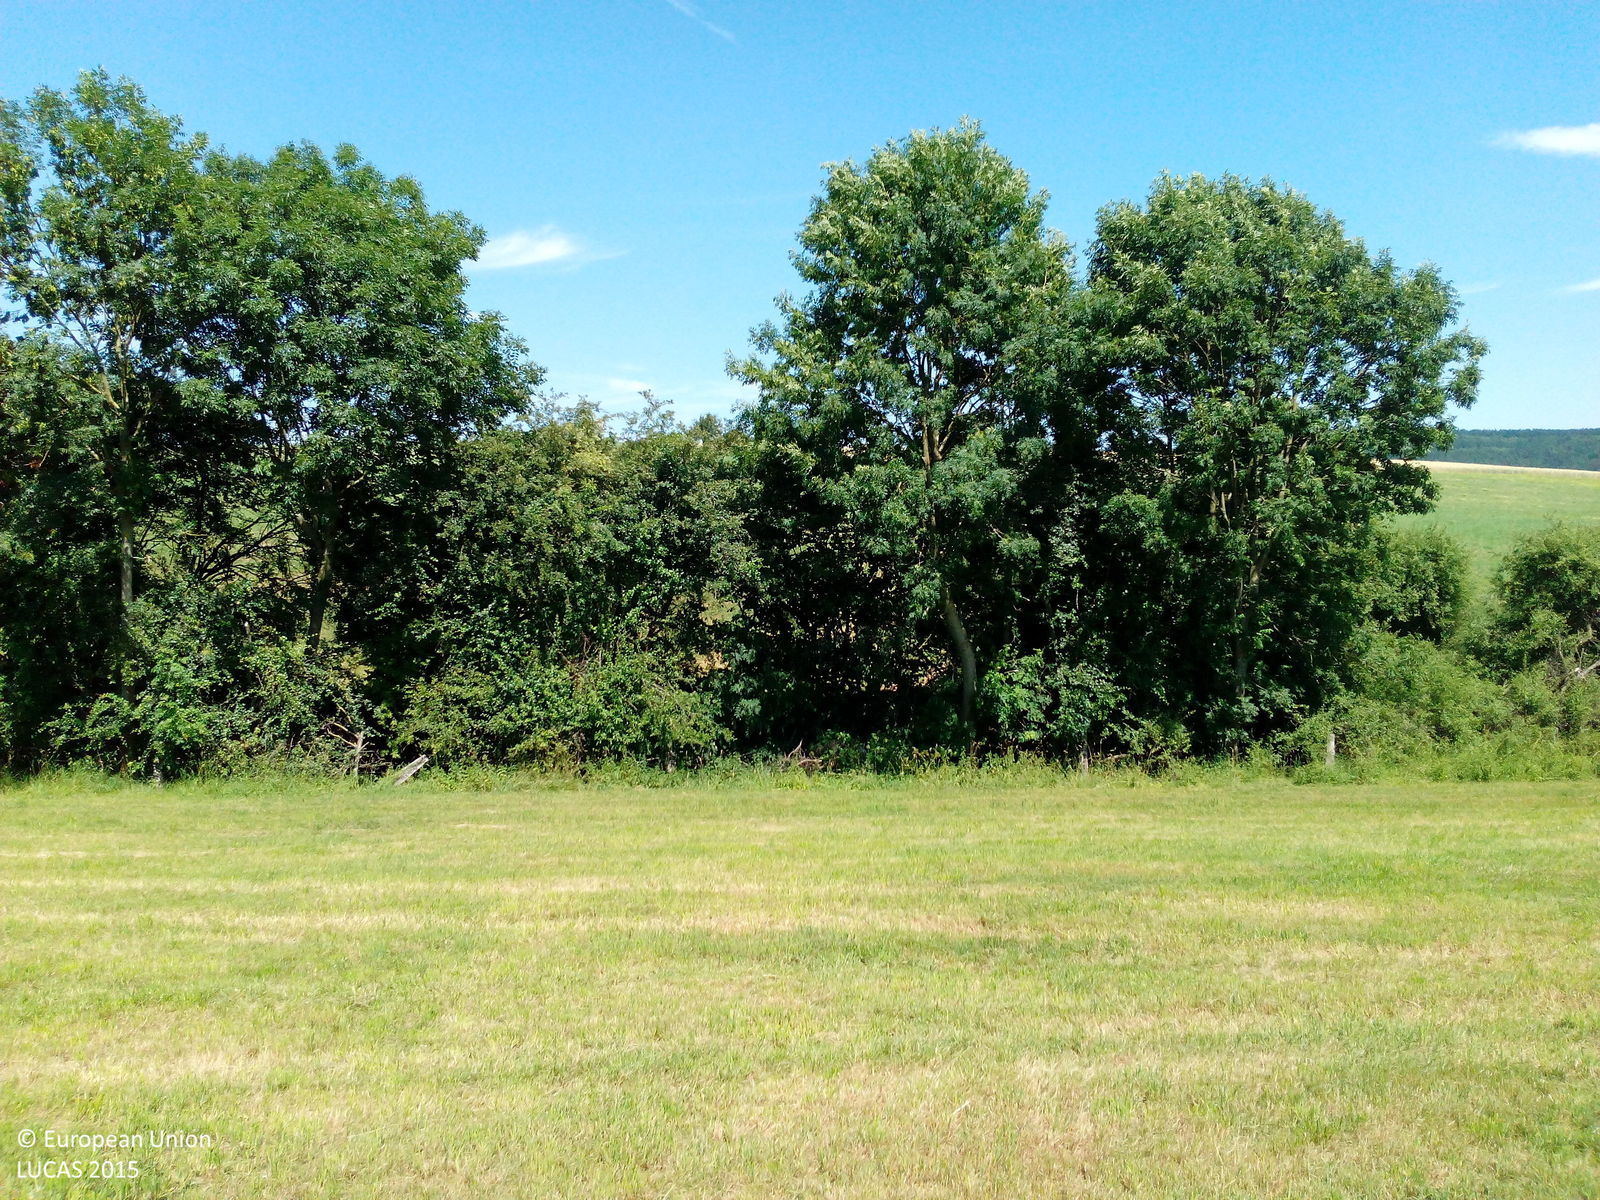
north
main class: Grassland
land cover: Grassland without tree/shrub cover
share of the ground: > 75 %
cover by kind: herbaceous plants 100 %
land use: Agriculture (excluding fallow land and kitchen gardens)
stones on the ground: < 10 %
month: July
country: DE
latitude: 51.7123
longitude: 9.8408
